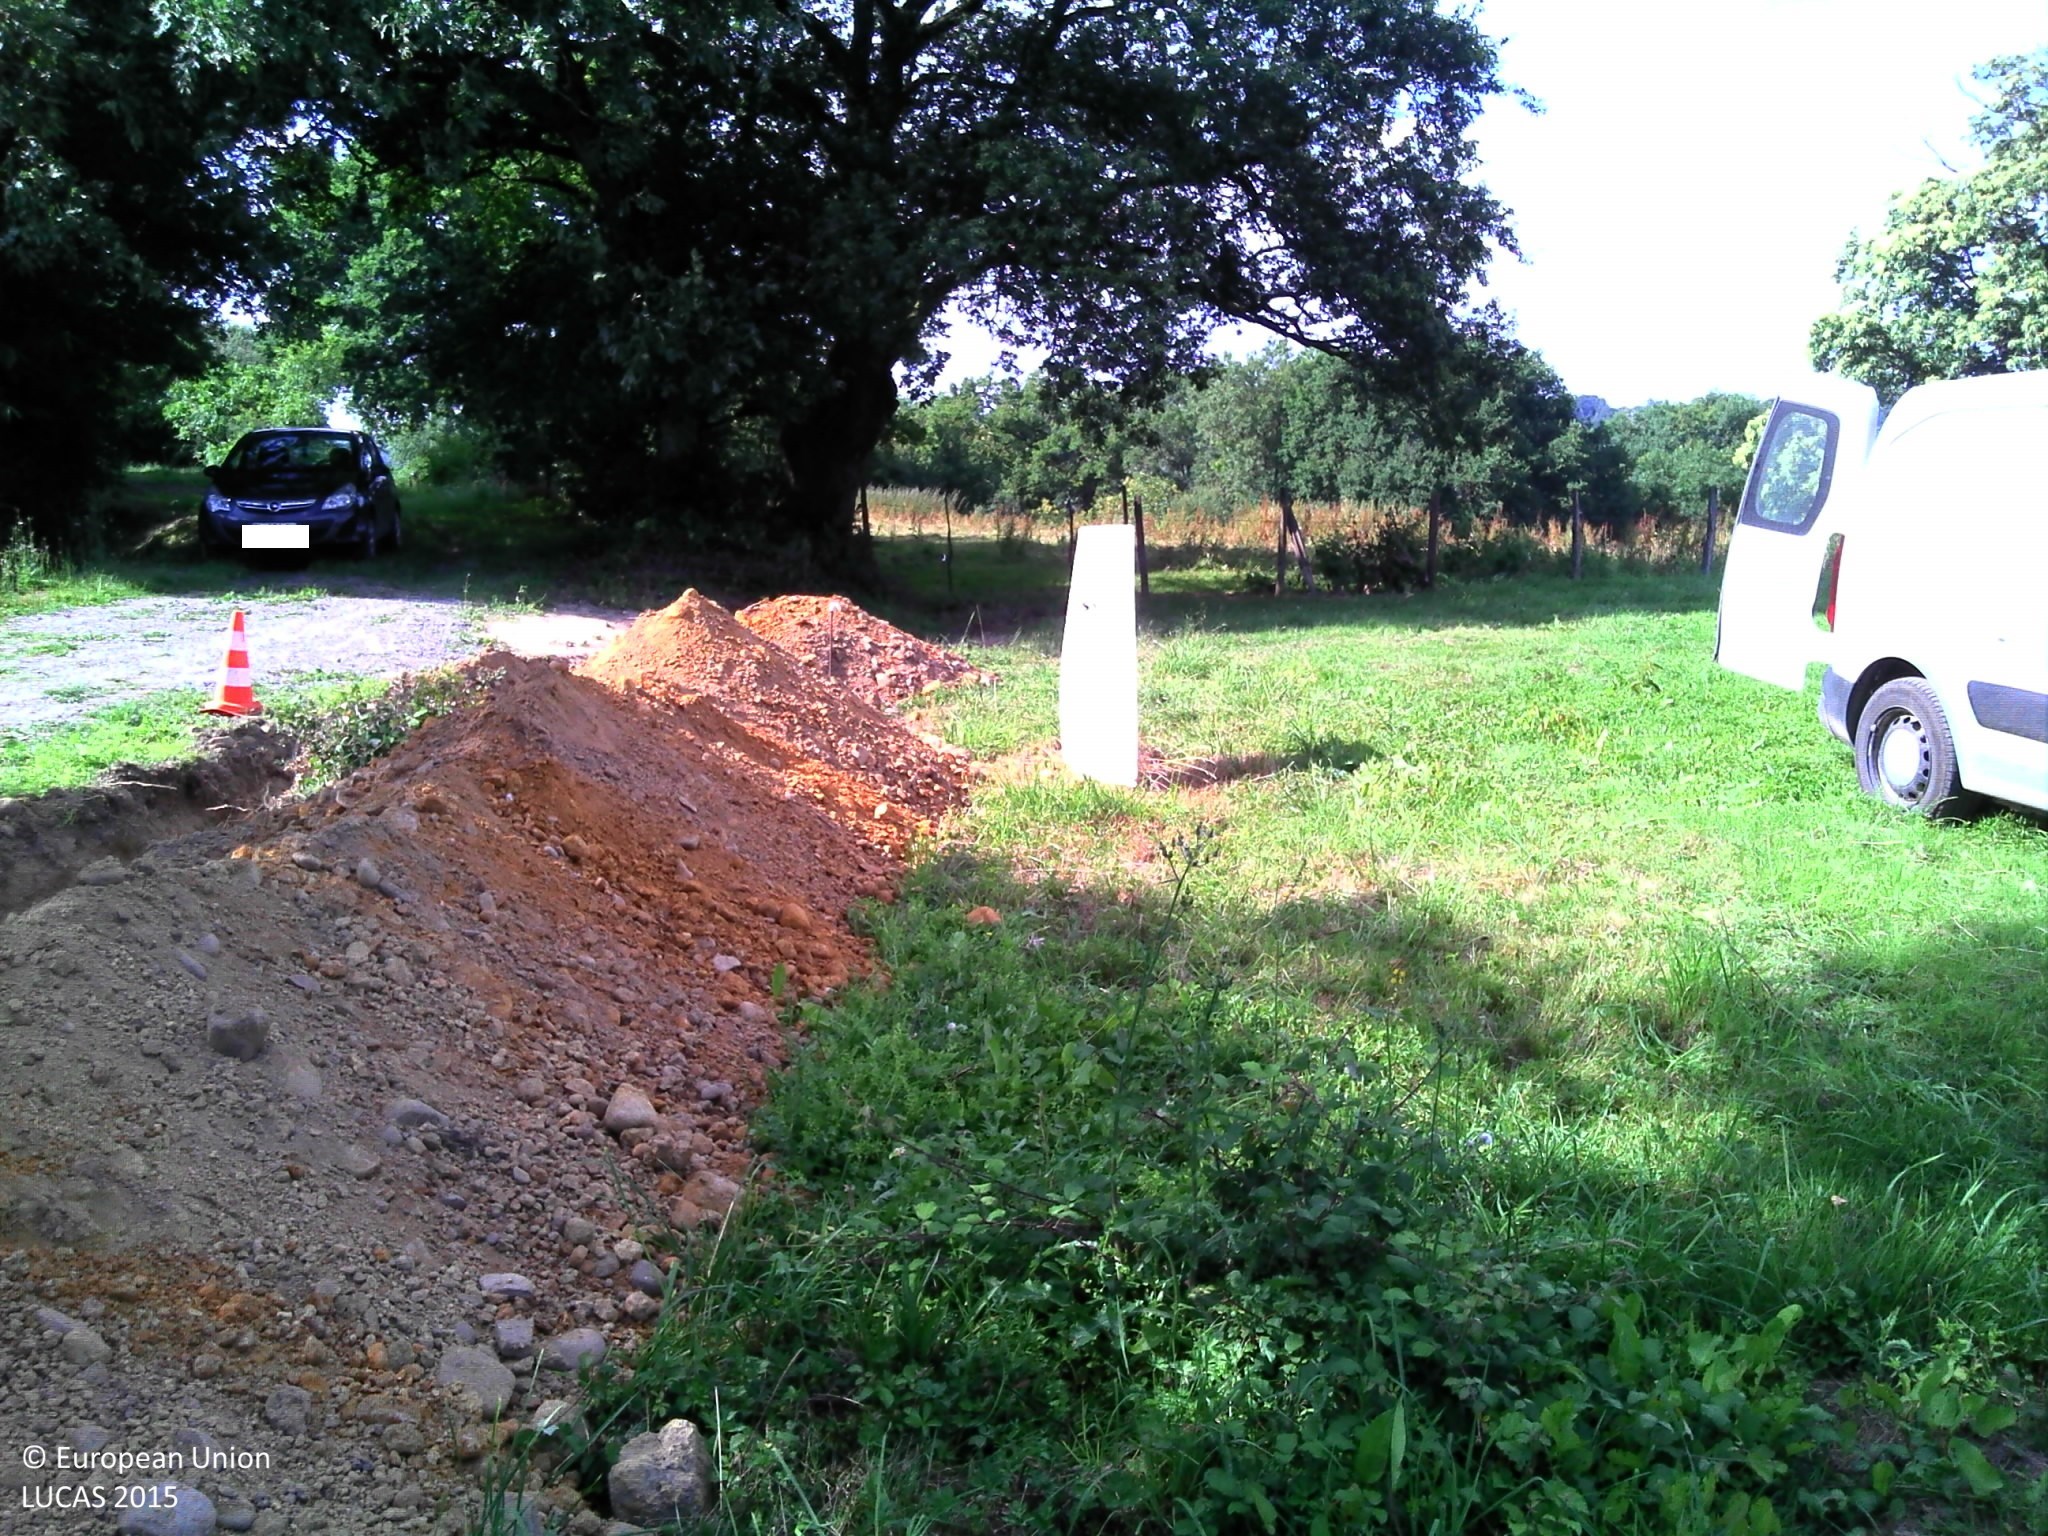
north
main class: Grassland
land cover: Grassland without tree/shrub cover
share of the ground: > 75 %
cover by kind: herbaceous plants 100 %
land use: Agriculture (excluding fallow land and kitchen gardens)
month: June
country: FR
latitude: 43.6362
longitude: -0.4841
